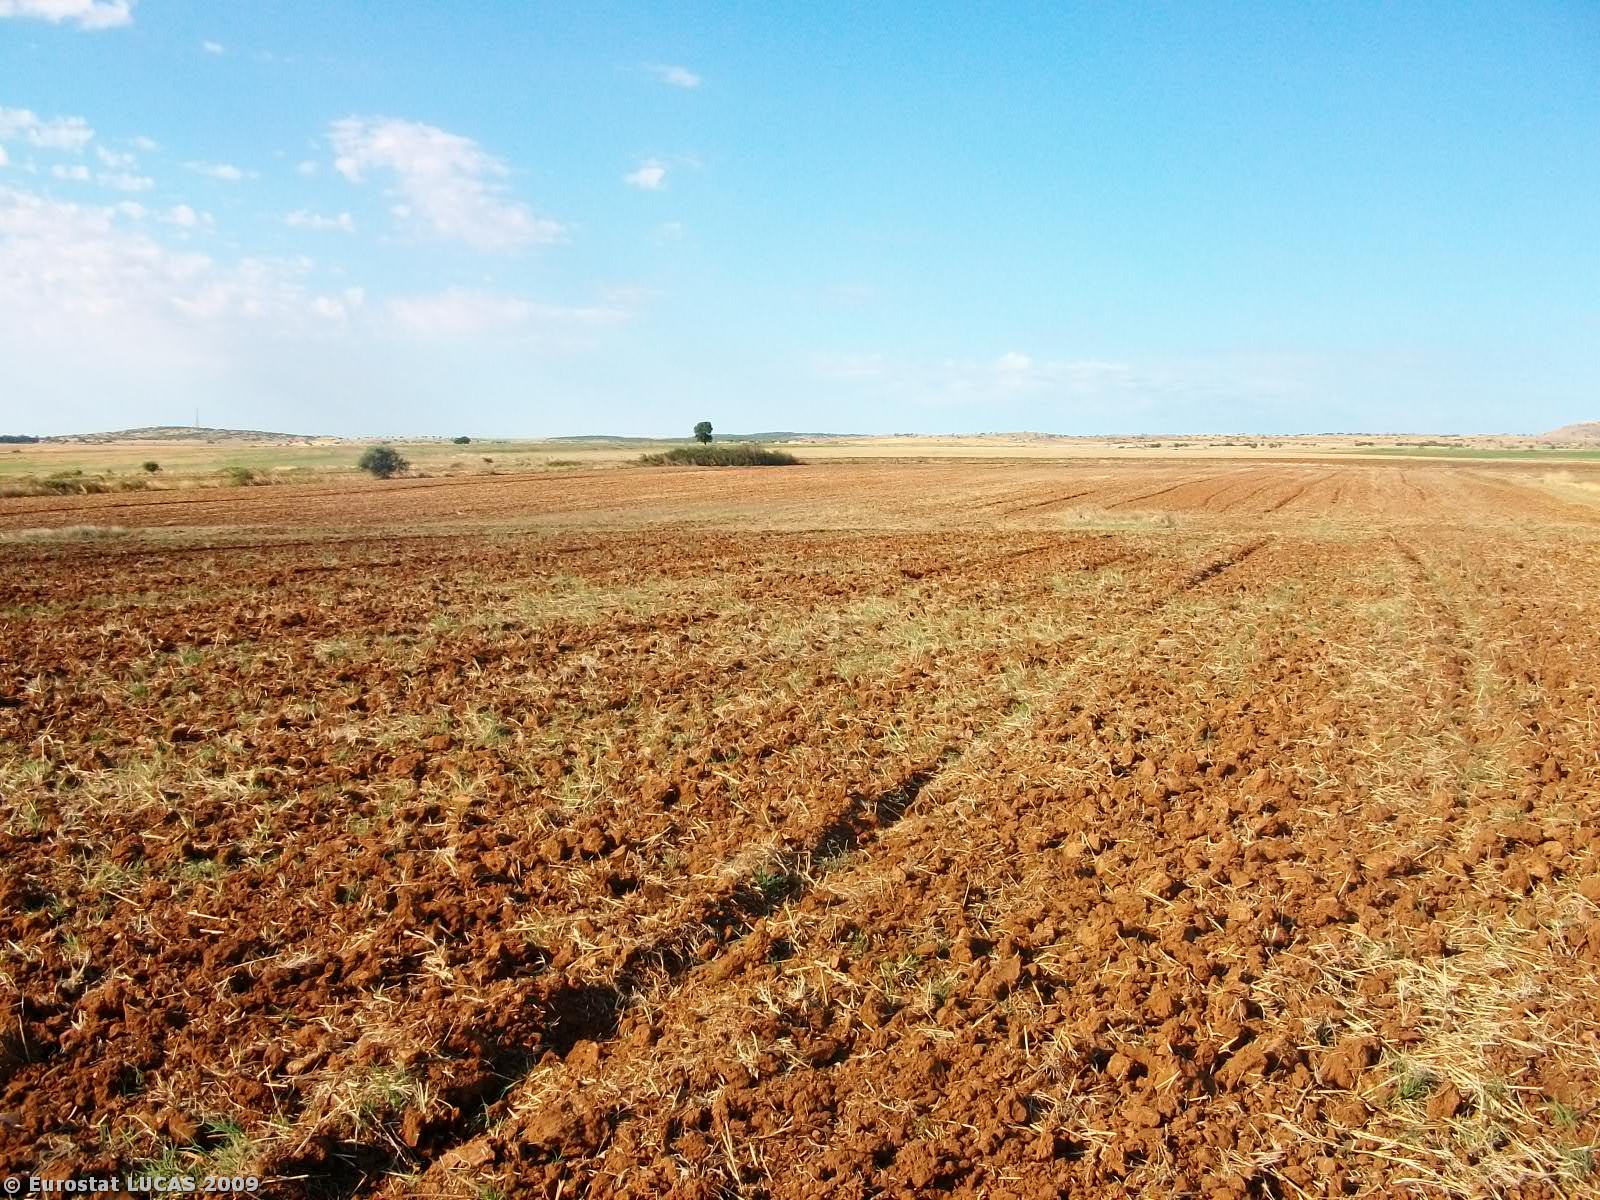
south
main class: Cropland
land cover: Barley
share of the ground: < 10 %
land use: Agriculture (excluding fallow land and kitchen gardens)
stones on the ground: < 10 %
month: July
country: GR
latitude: 41.0408
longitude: 22.7499
